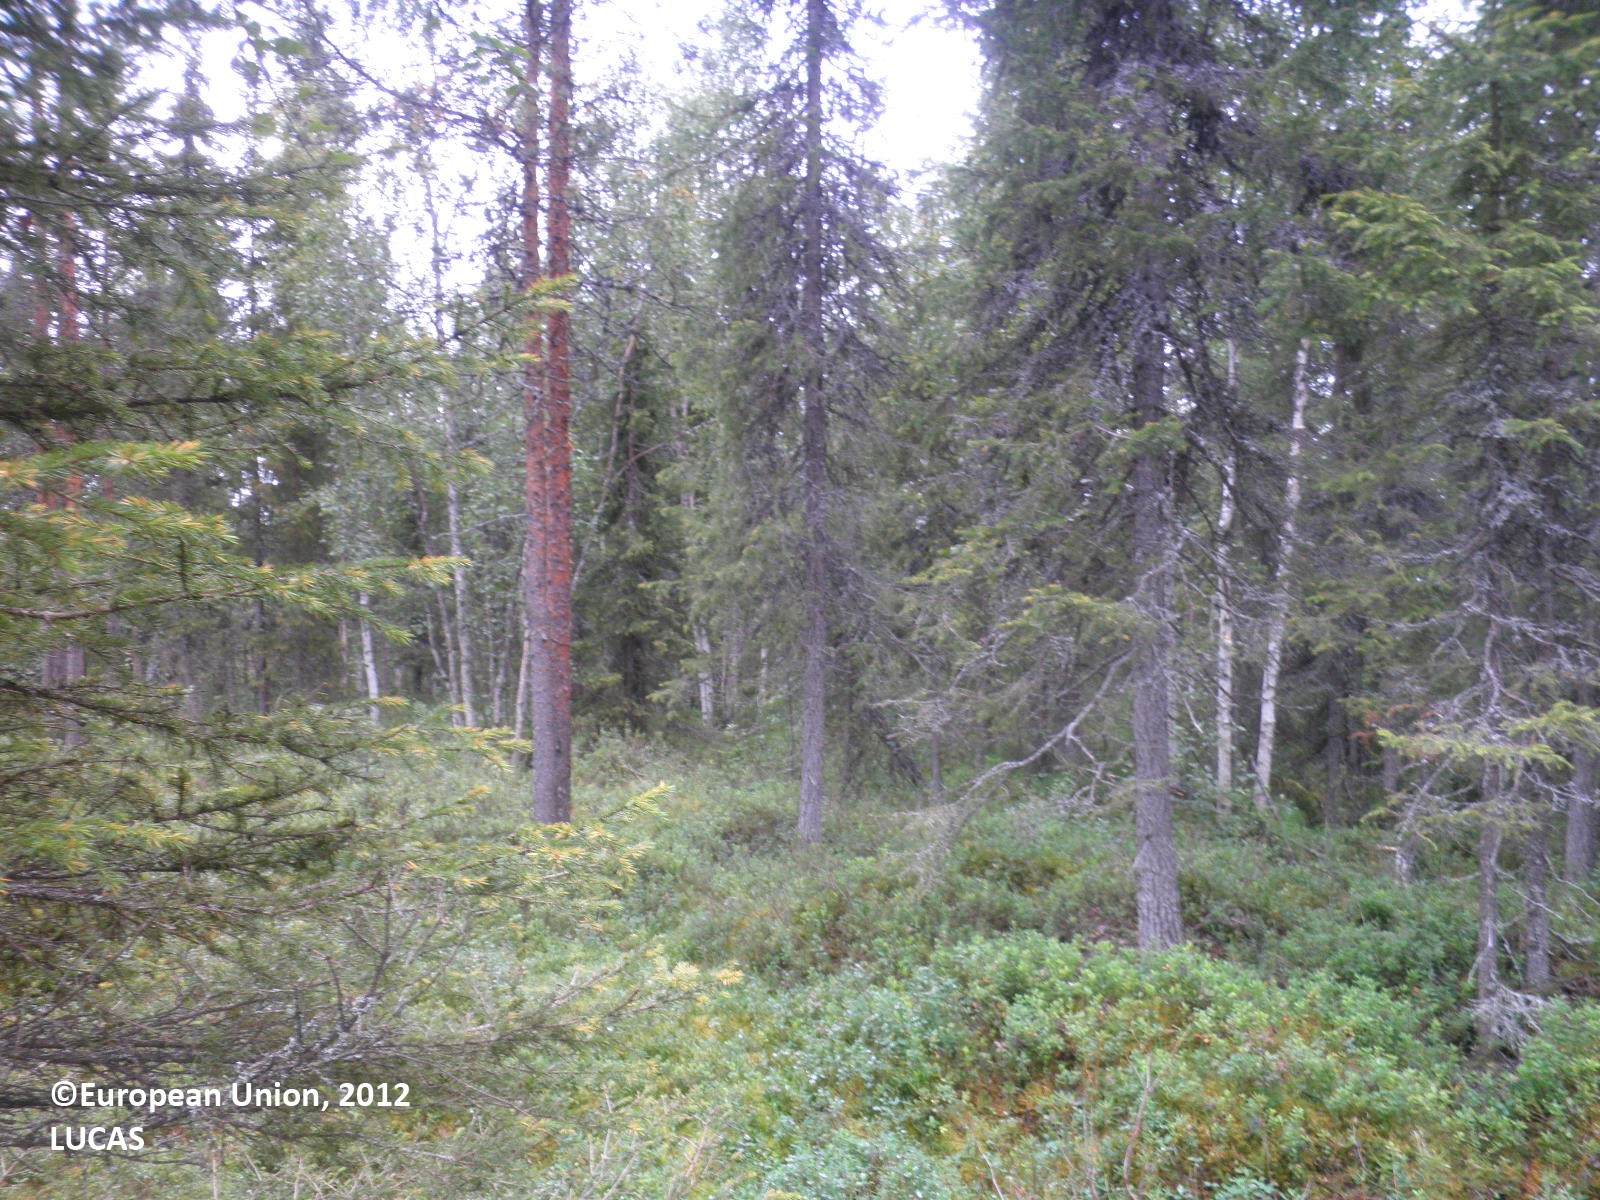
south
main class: Woodland
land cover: Pine dominated mixed woodland
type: boreal forest
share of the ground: 25 - 50 %
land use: Forestry
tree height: > 5 m
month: July
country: FI
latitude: 66.9724
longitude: 28.9142
